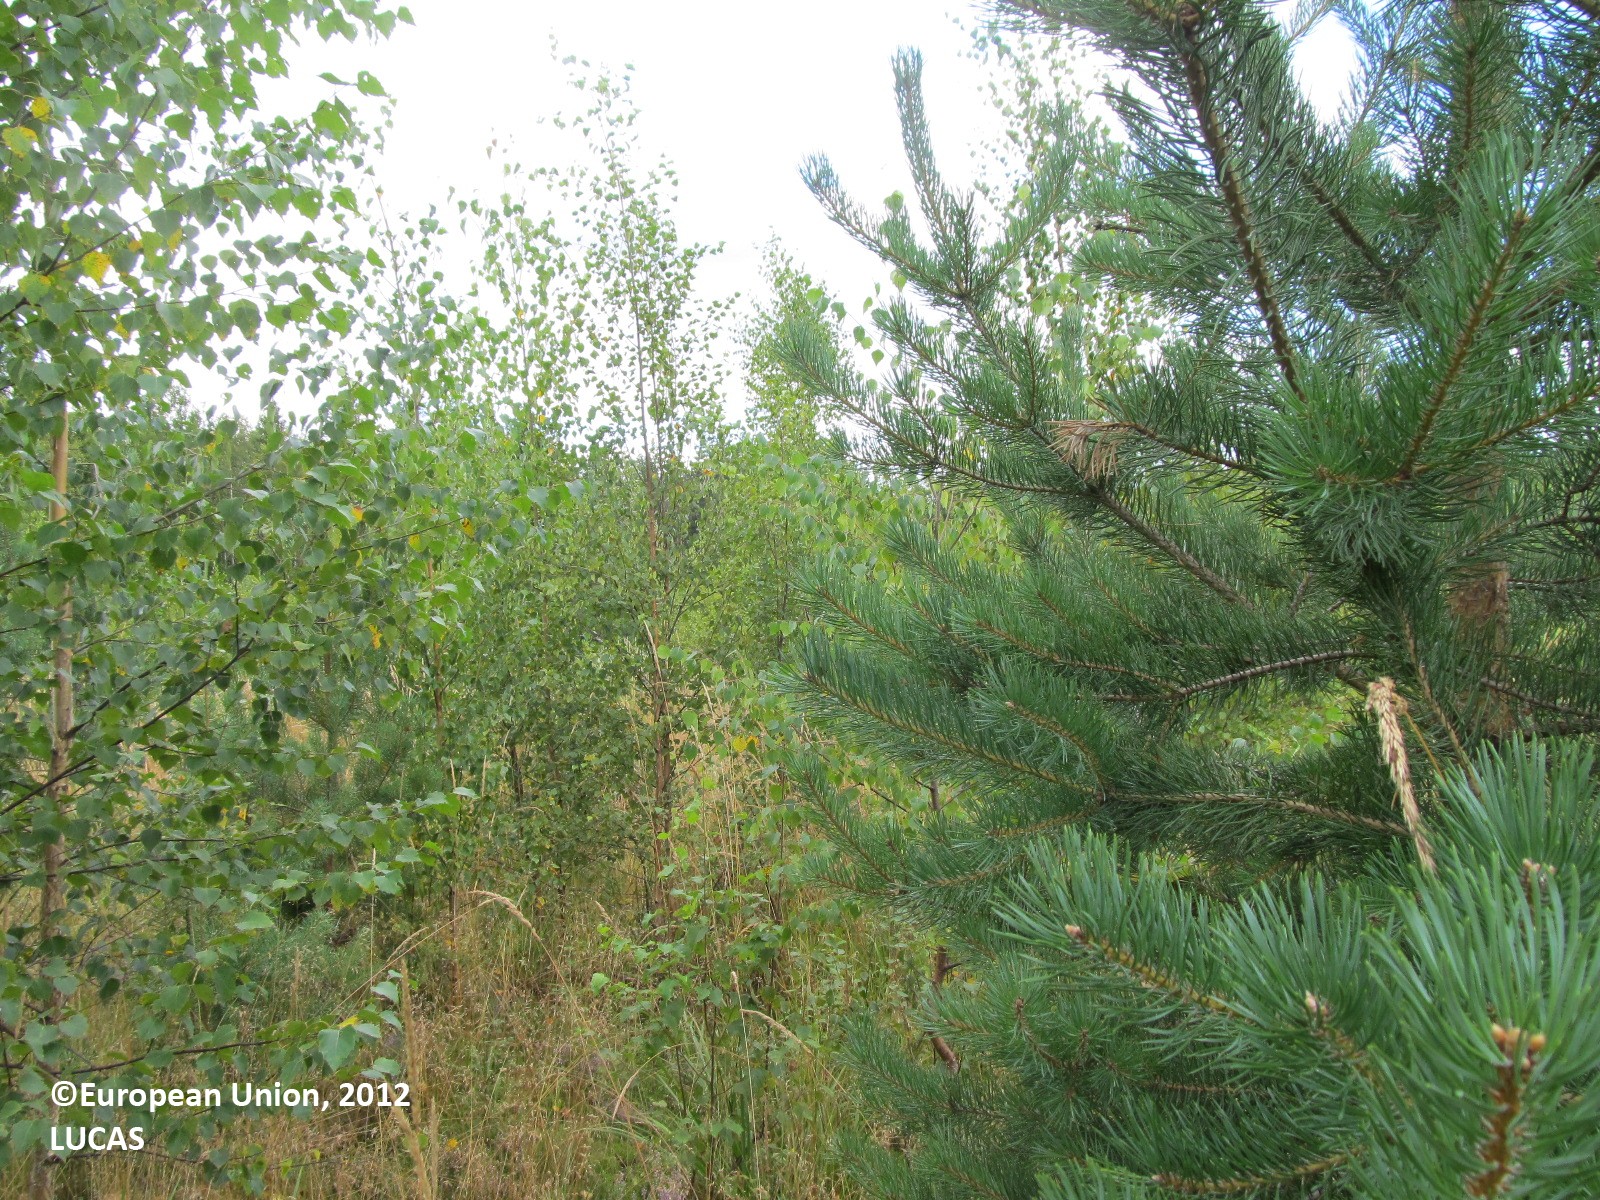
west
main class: Woodland
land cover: Spruce dominated mixed woodland
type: boreal forest
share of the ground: 25 - 50 %
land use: Forestry
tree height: < 5 m
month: August
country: FI
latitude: 61.7100
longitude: 27.7553
